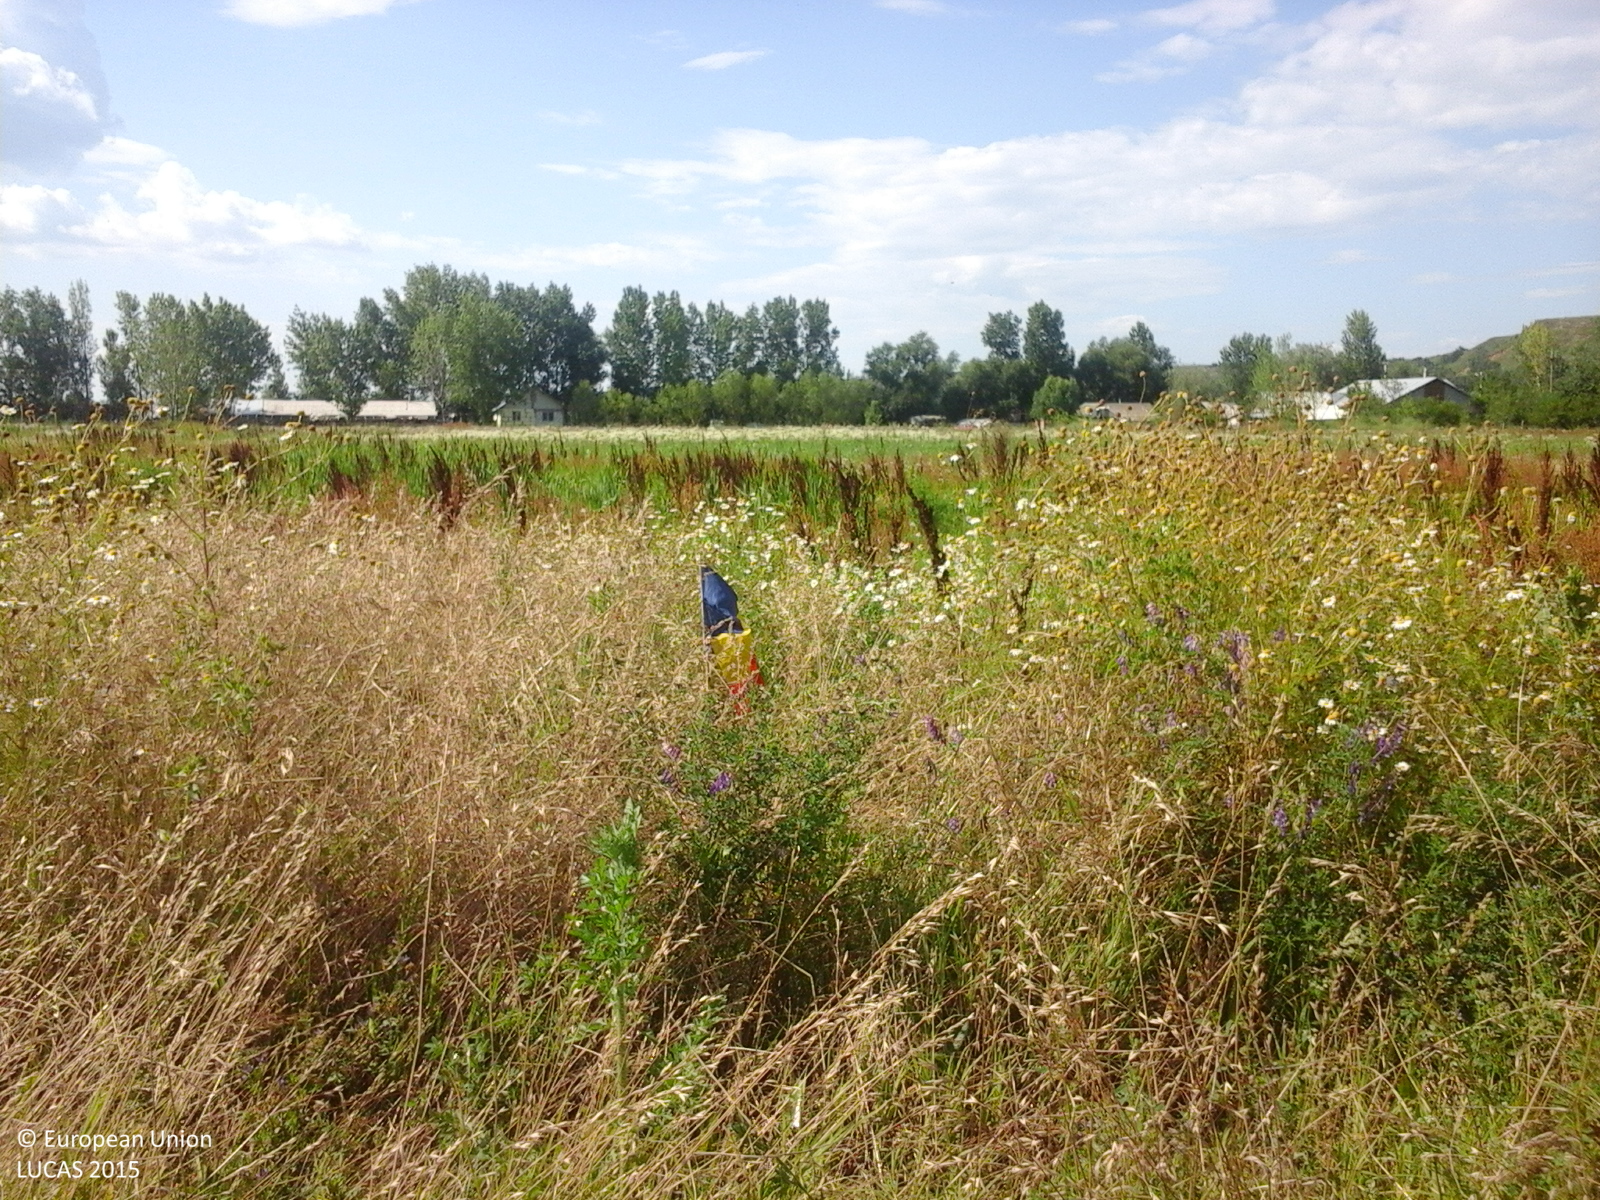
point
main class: Grassland
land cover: Grassland without tree/shrub cover
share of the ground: > 75 %
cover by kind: herbaceous plants 100 %
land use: Agriculture (excluding fallow land and kitchen gardens)
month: July
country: RO
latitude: 44.0566
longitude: 24.6370
